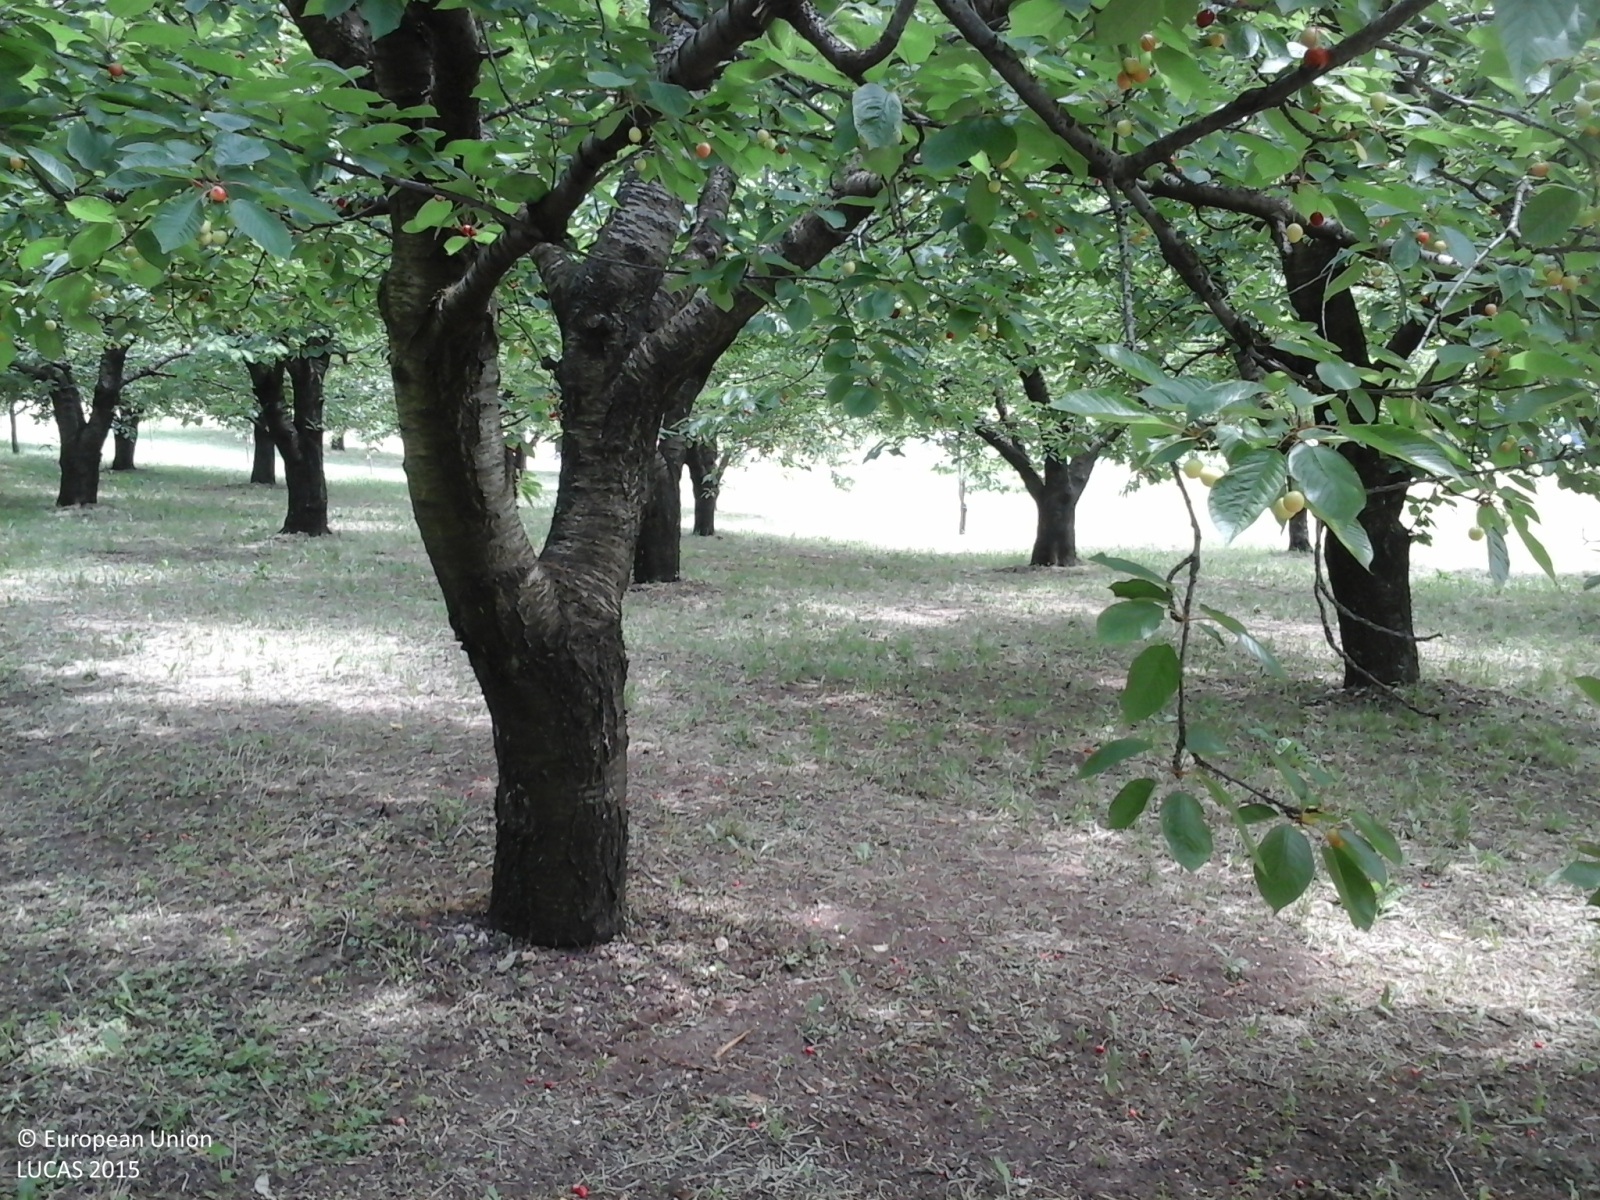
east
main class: Cropland
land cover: Cherry fruit
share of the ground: > 75 %
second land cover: Grassland without tree/shrub cover
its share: > 75 %
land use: Agriculture (excluding fallow land and kitchen gardens)
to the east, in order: Cherry fruit; Grassland without tree/shrub cover; Tracks; Dry stone walls; Fences; Cherry fruit; Fences; Paved roads, cycling and walking lanes; Grass margins; Fences; Cherry fruit; Dry stone walls; Cherry fruit
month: June
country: IT
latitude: 45.5724
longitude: 10.9339
